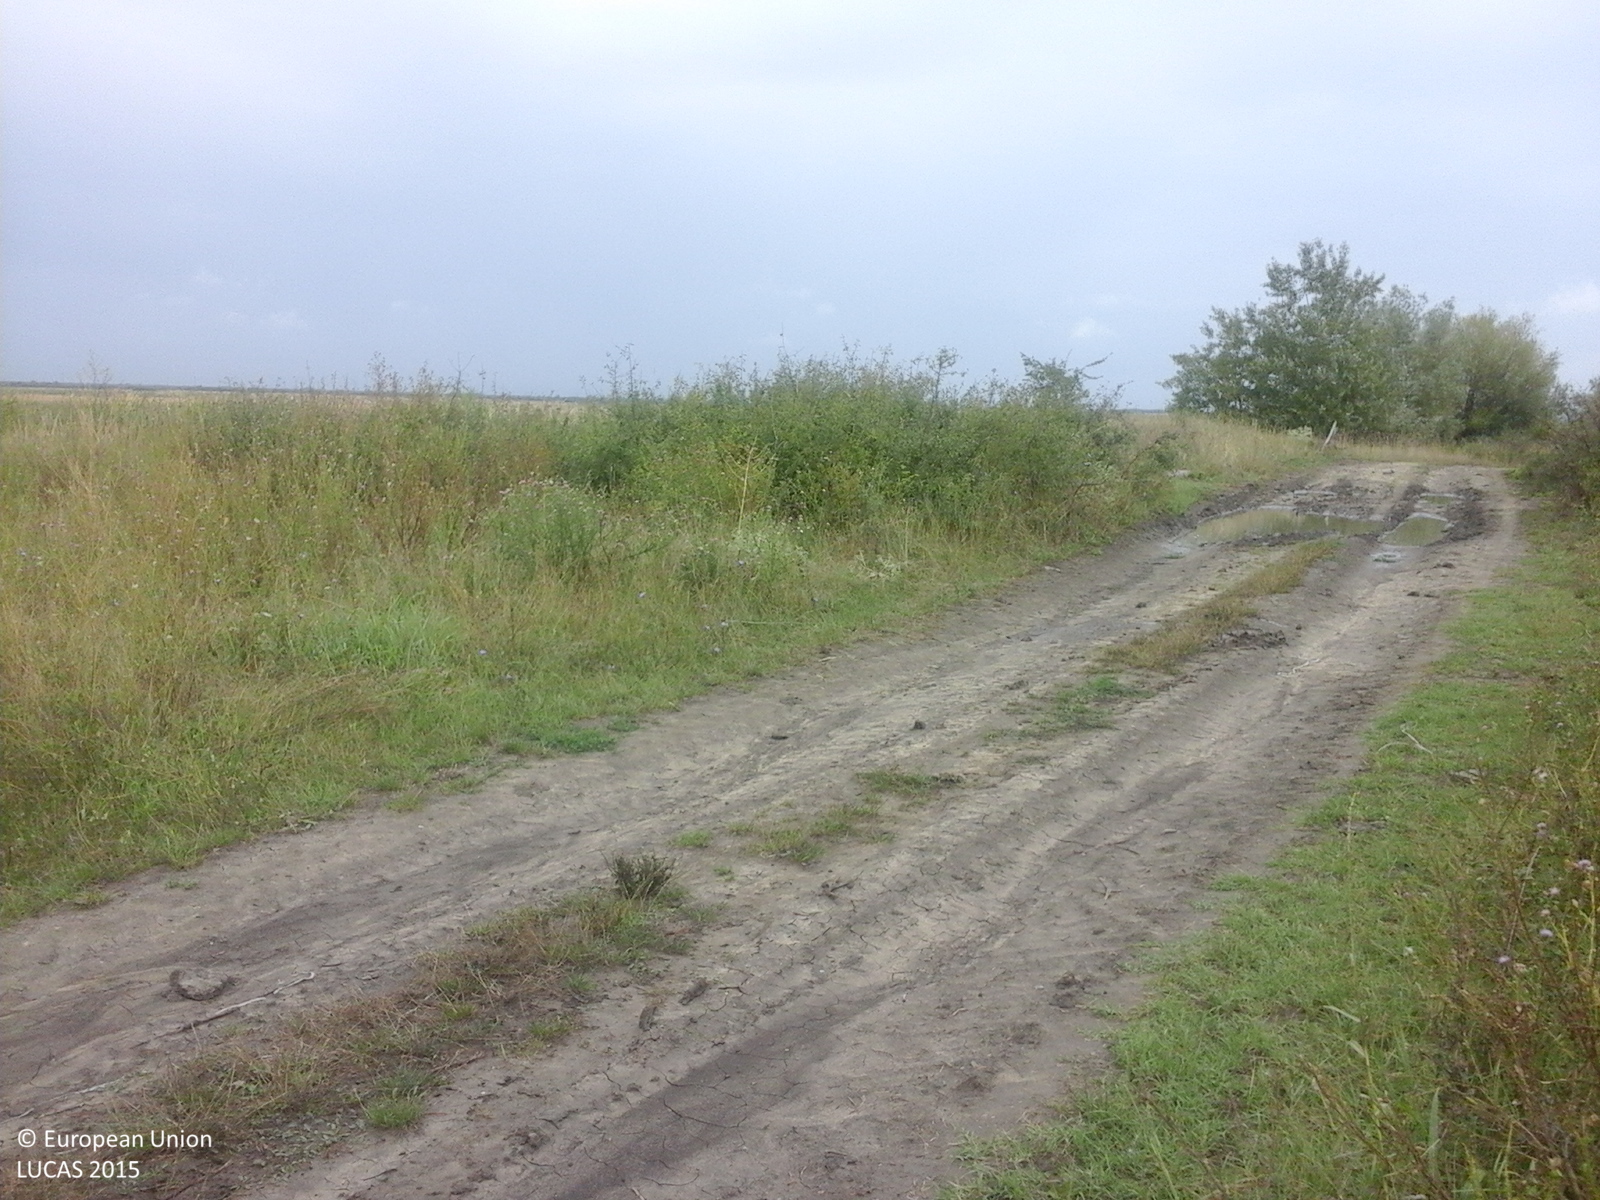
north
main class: Grassland
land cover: Grassland without tree/shrub cover
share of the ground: > 75 %
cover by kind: herbaceous plants 100 %
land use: Agriculture (excluding fallow land and kitchen gardens)
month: August
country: RO
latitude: 45.4413
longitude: 20.9565
